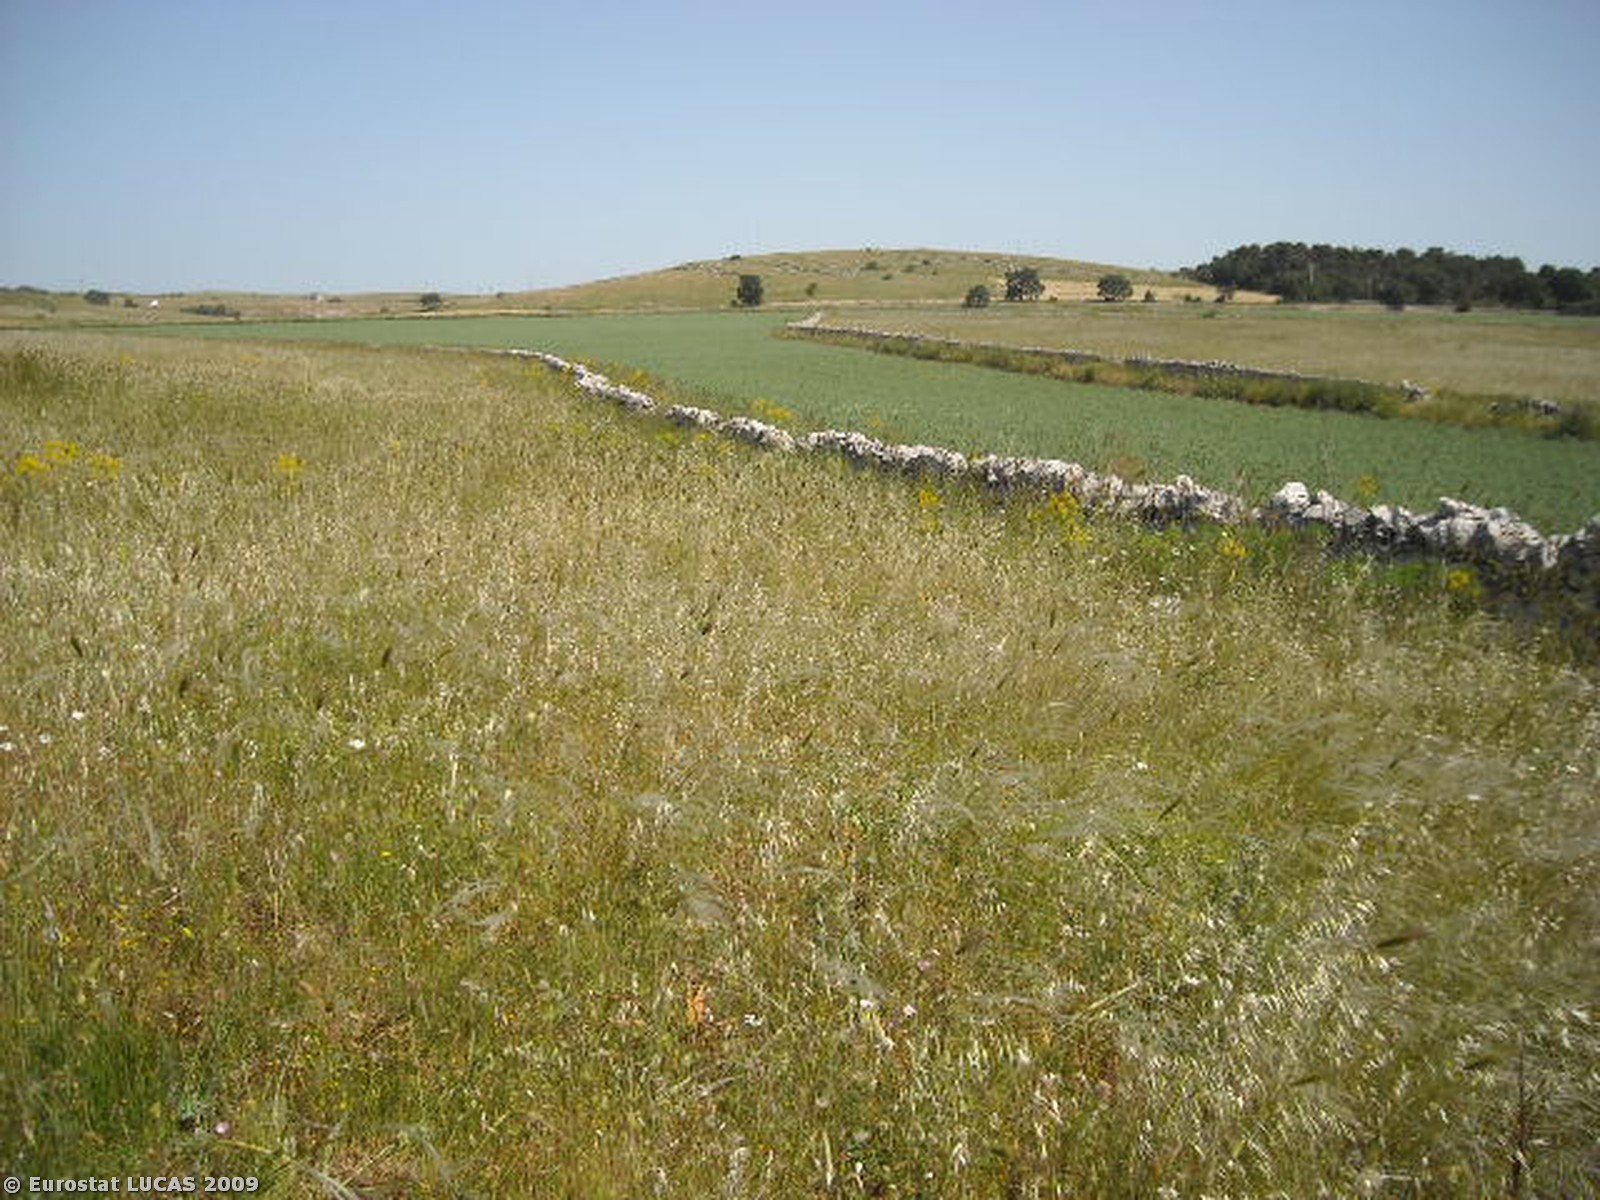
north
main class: Grassland
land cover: Grassland without tree/shrub cover
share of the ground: > 75 %
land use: Fallow land
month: May
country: IT
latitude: 40.8609
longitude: 16.6097
